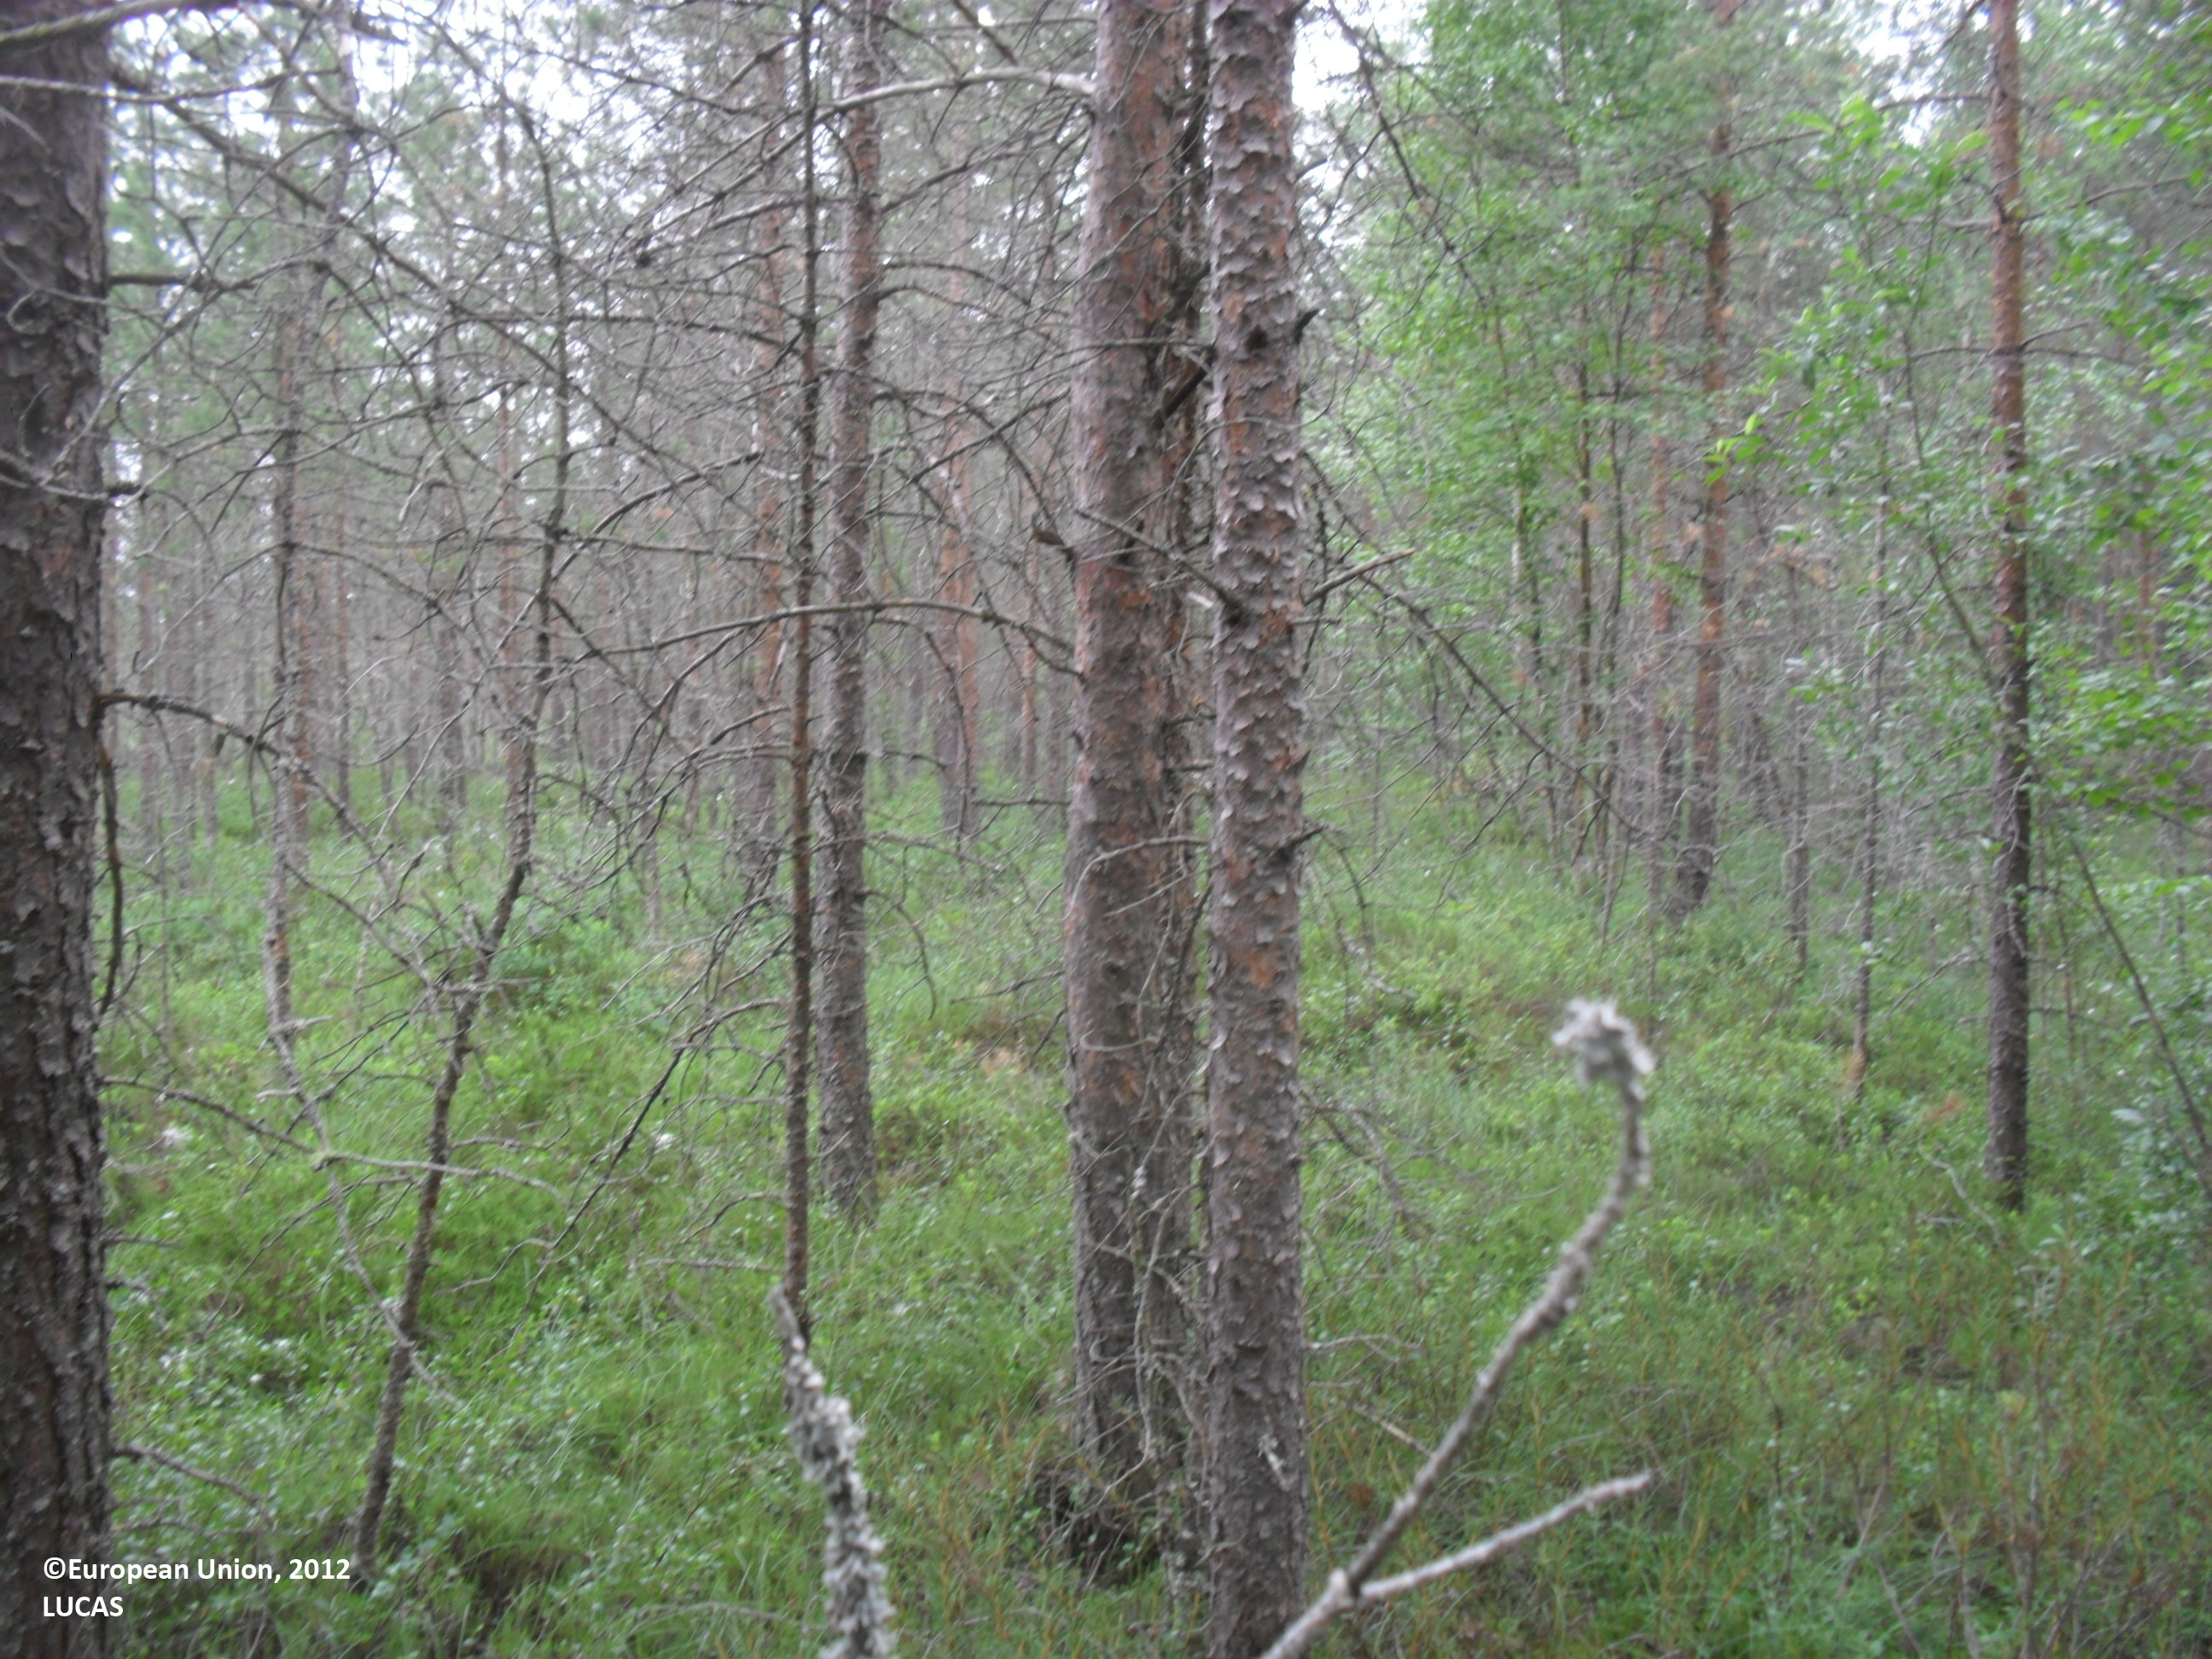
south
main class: Woodland
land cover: Pine dominated coniferous woodland
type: boreal forest
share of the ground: 50 - 75 %
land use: Forestry
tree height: > 5 m
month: July
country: FI
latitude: 63.6008
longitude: 23.6710
